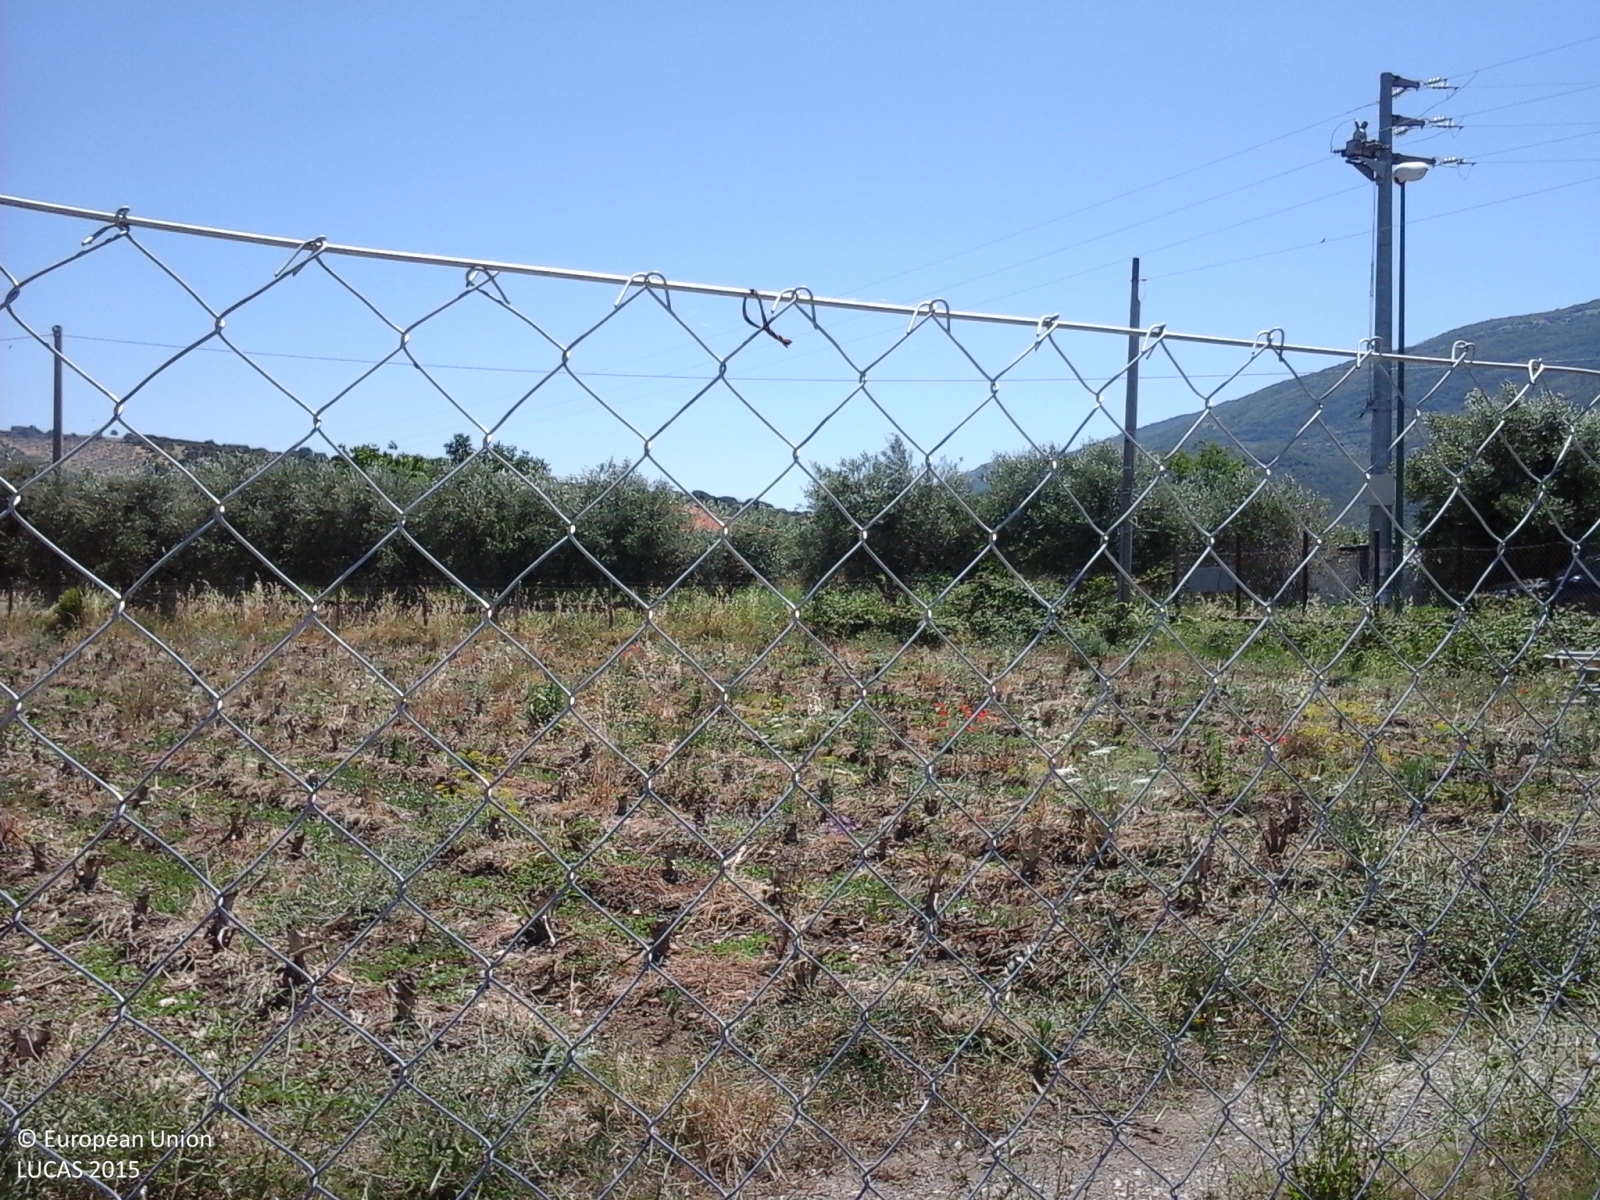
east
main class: Cropland
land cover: Other fresh vegetables
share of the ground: 50 - 75 %
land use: Agriculture (excluding fallow land and kitchen gardens)
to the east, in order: Other fresh vegetables; Fences; Grass margins; Paved roads, cycling and walking lanes; Olive groves; Electric lines; Tracks; Other bare soil; Nuts trees; Fences; Spontaneously vegetated surfaces; Olive groves; Lucerne; Olive groves; Electric lines; Other fresh vegetables; Lucerne; Olive groves; Other bare soil; Paved roads, cycling and walking lanes; Shrubland without tree cover; Ditches and canals; Paved roads, cycling and walking lanes; Electric lines; Tracks
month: June
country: IT
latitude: 40.4642
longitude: 15.0379
